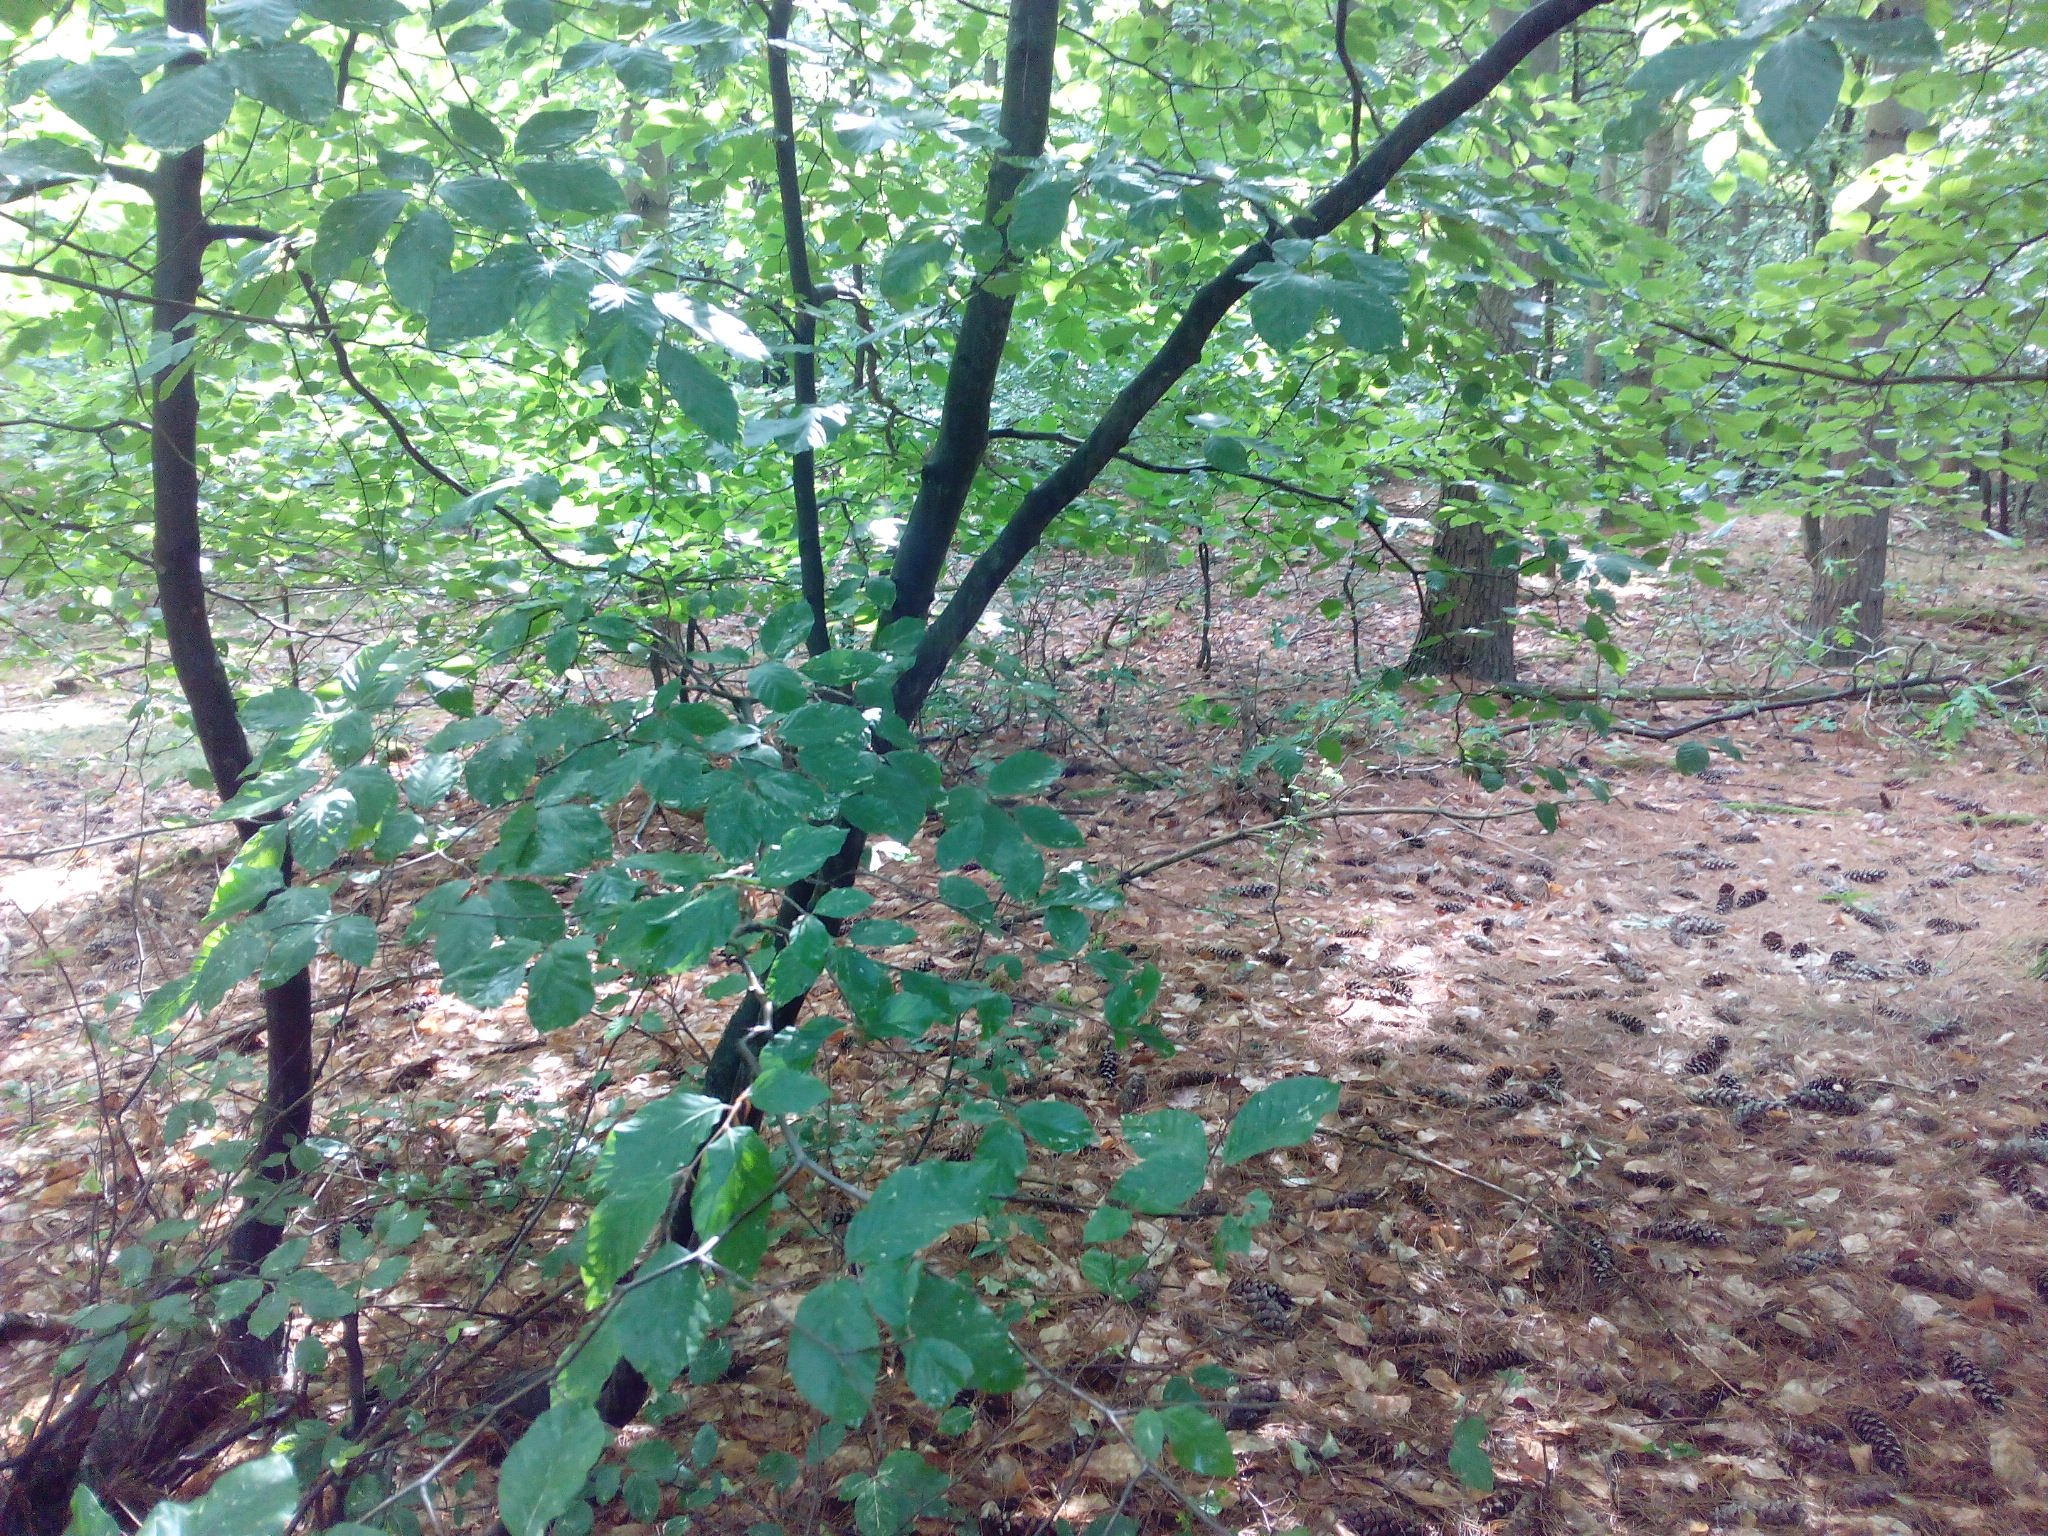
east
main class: Woodland
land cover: Pine dominated mixed woodland
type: hemiboreal forest and nemoral coniferous forest and mixed broadleaved-coniferous forest
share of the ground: > 75 %
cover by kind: coniferous forest trees 60 %, broadleaved forest trees 25 %, unconsolidated bare surface 10 %, shrubs 5 %
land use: Forestry
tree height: > 5 m
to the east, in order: Pine dominated mixed woodland; Pine dominated coniferous woodland; Tracks; Pine dominated coniferous woodland; Tracks; Pine dominated mixed woodland
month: June
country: DE
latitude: 53.2699
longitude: 13.1935
